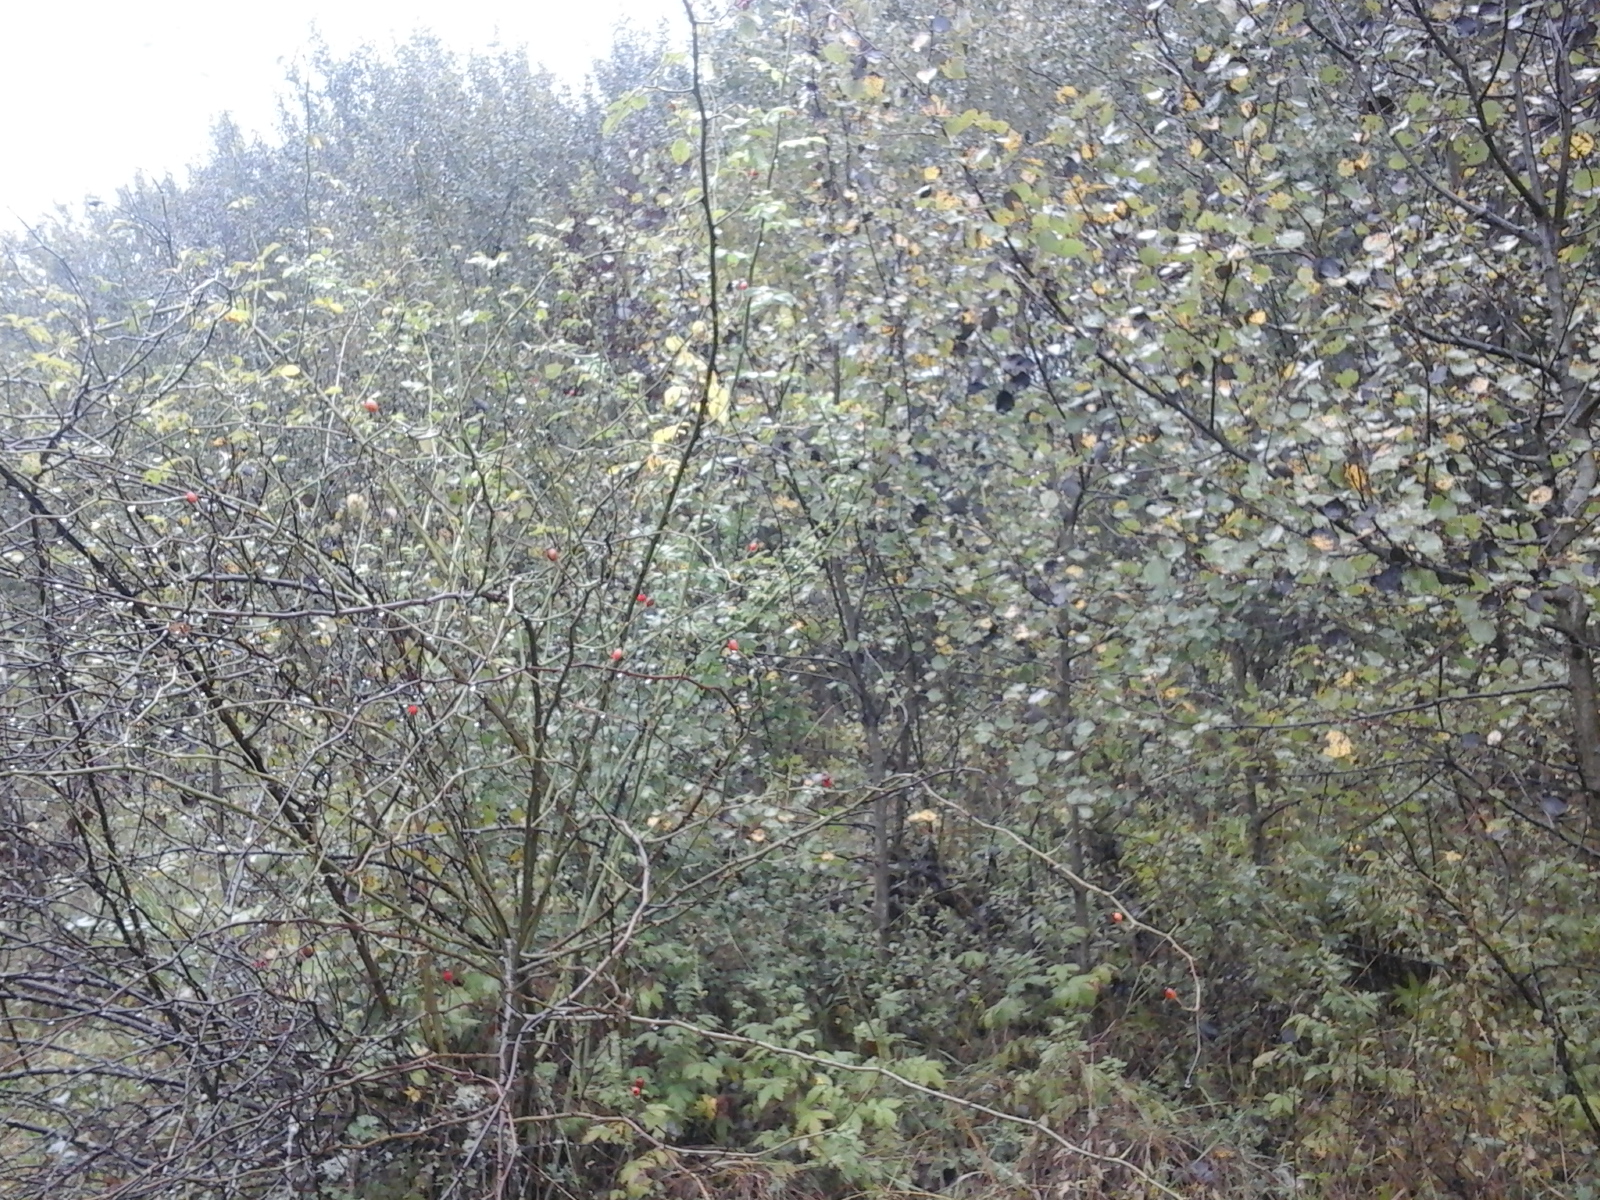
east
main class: Grassland
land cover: Grassland with sparse tree/shrub cover
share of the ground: > 75 %
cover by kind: herbaceous plants 85 %, shrubs 10 %, broadleaved forest trees 5 %
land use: Fallow land
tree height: < 5 m
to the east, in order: Grassland with sparse tree/shrub cover; Broadleaved woodland; Grassland with sparse tree/shrub cover; Broadleaved woodland
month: September
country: RO
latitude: 44.8844
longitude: 23.6692
